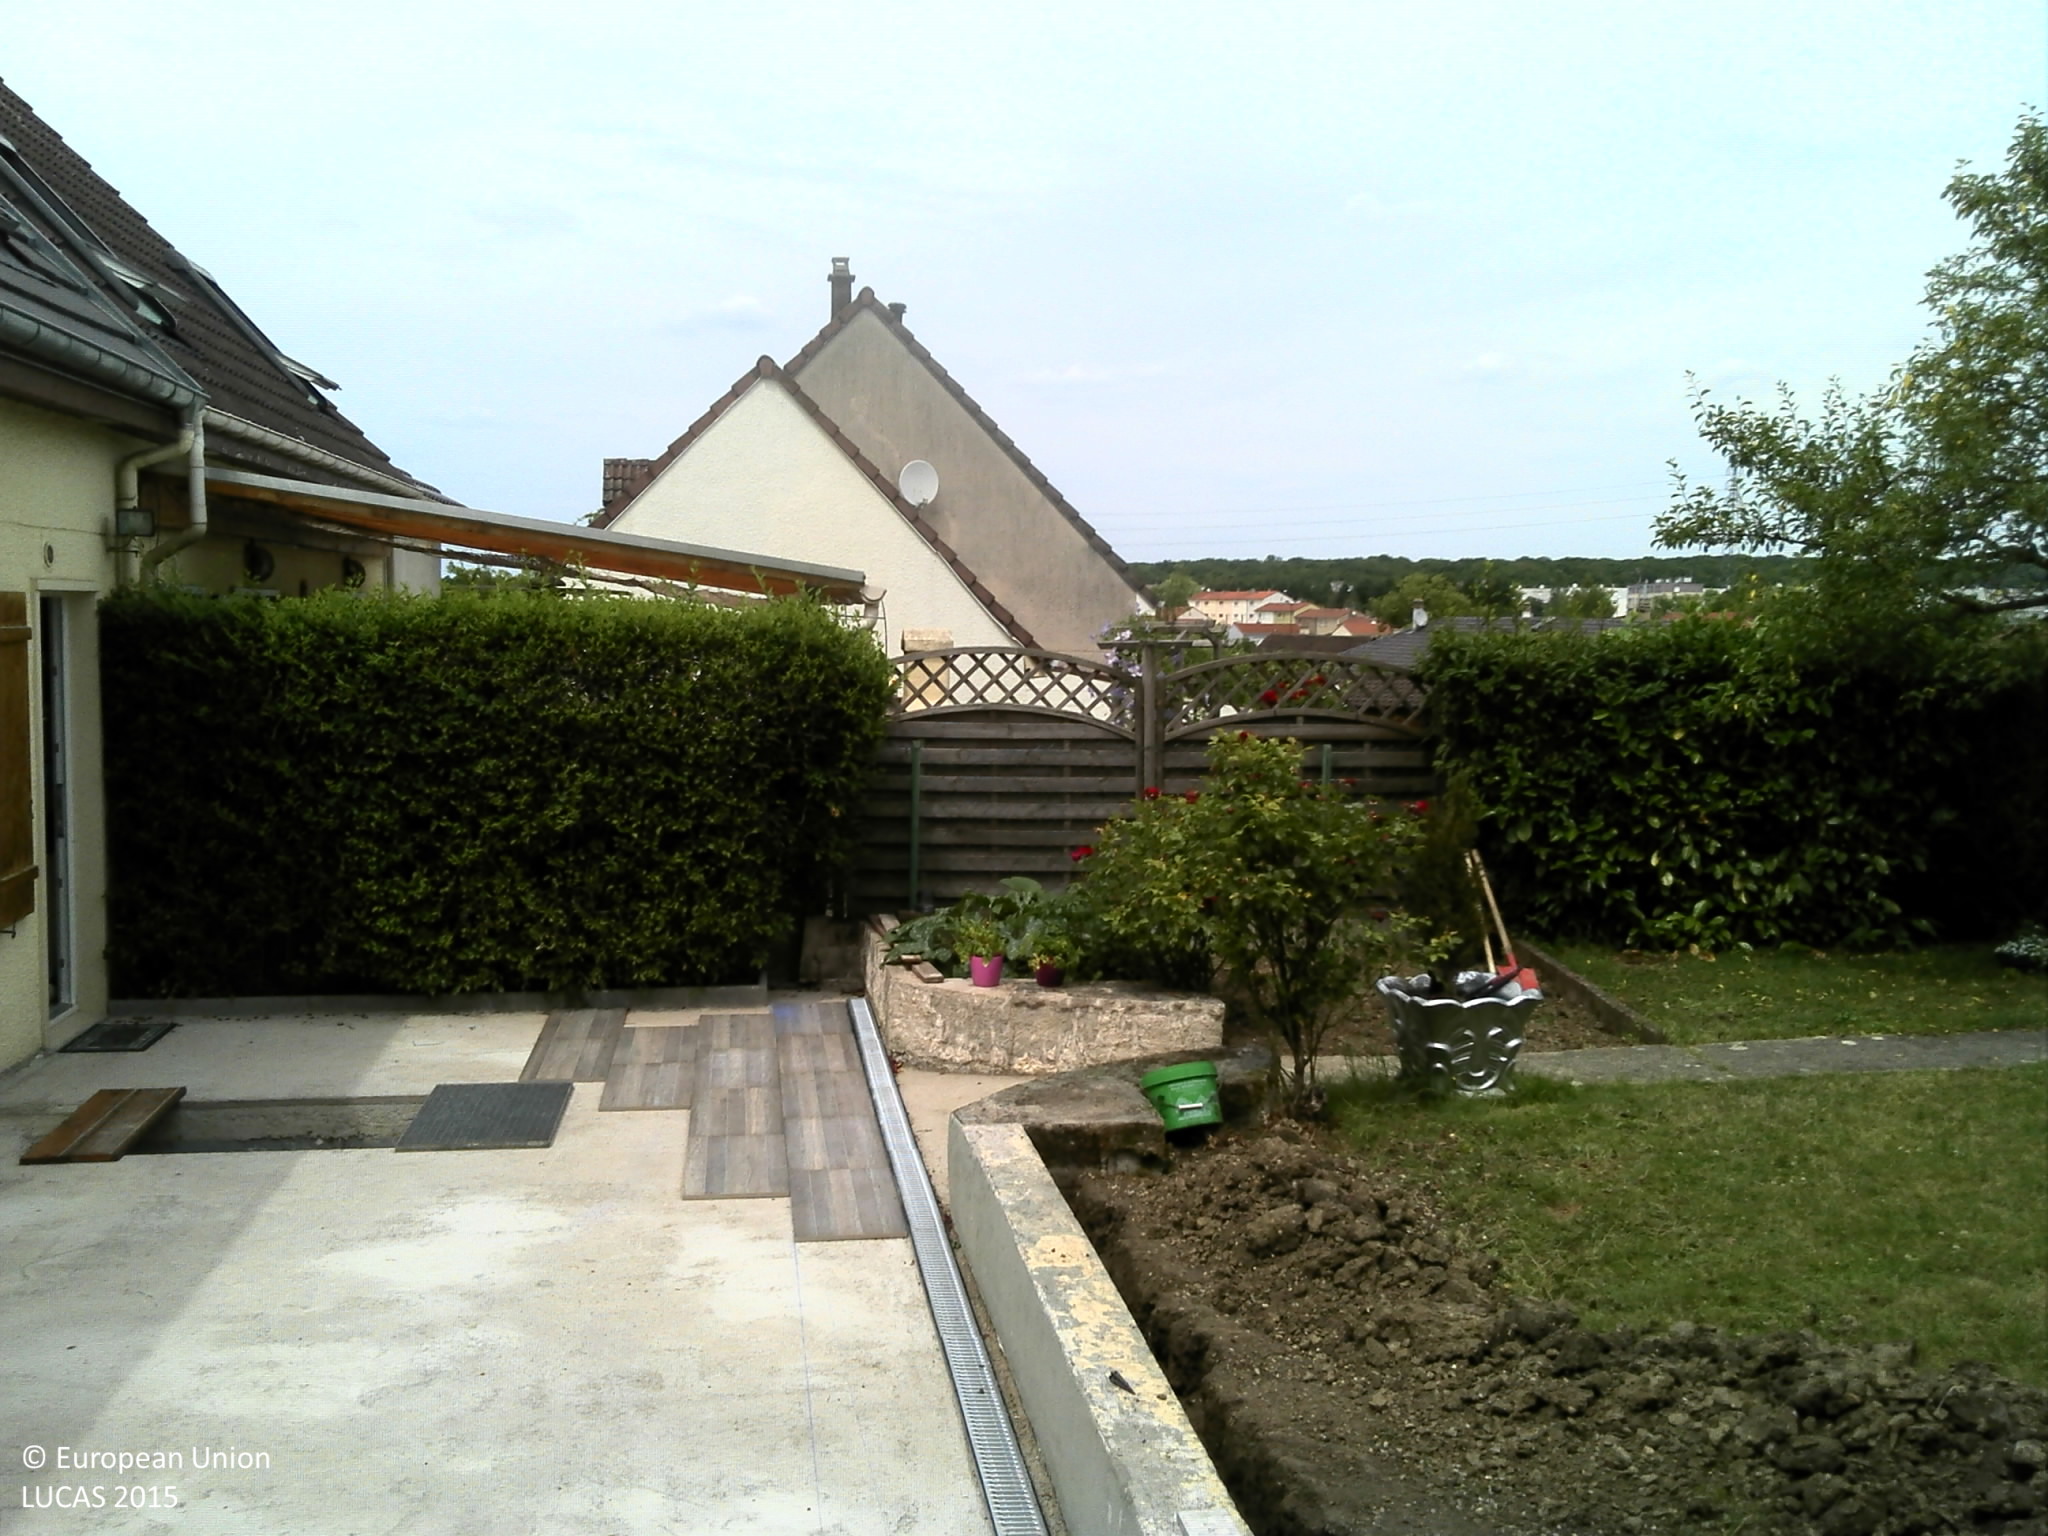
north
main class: Grassland
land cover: Grassland with sparse tree/shrub cover
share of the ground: > 75 %
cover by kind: herbaceous plants 95 %, coniferous forest trees 5 %
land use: Residential
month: June
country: FR
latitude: 49.2924
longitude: 6.1910
